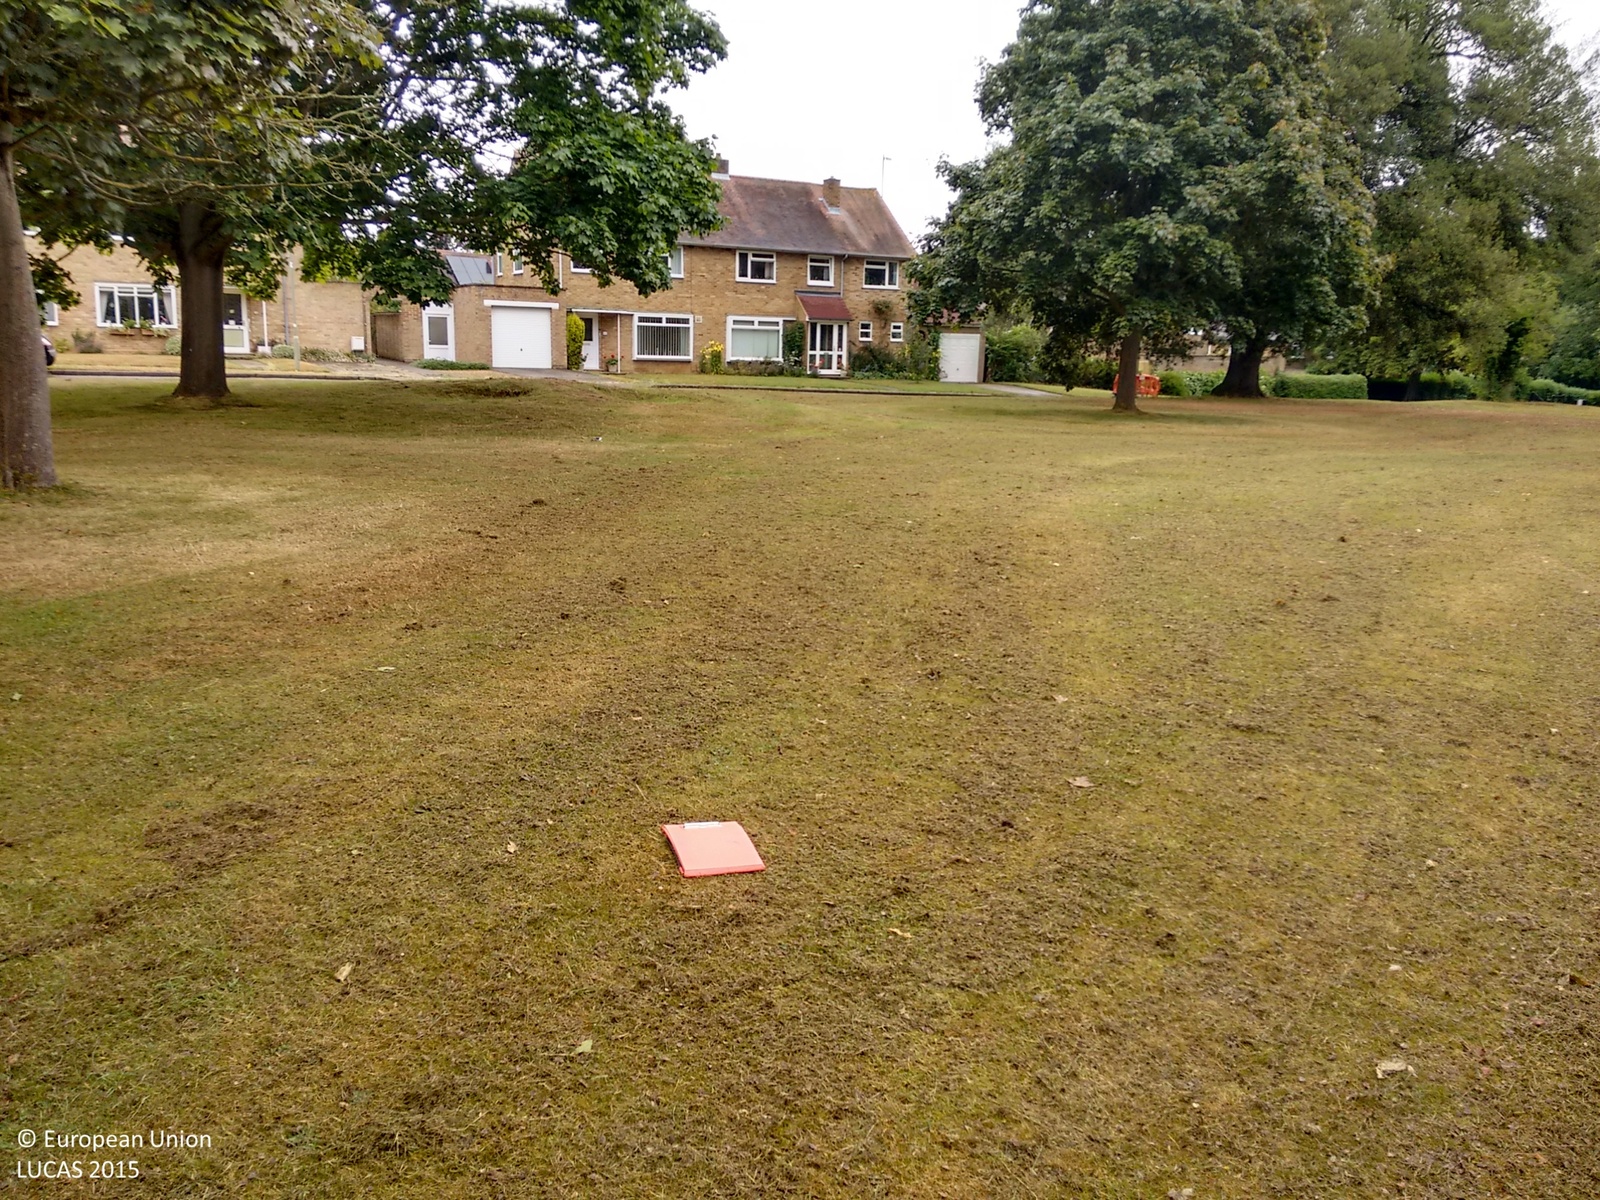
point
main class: Grassland
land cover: Grassland with sparse tree/shrub cover
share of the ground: > 75 %
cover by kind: herbaceous plants 95 %, broadleaved forest trees 5 %
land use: Residential
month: July
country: GB
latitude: 51.6740
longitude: -1.2842
